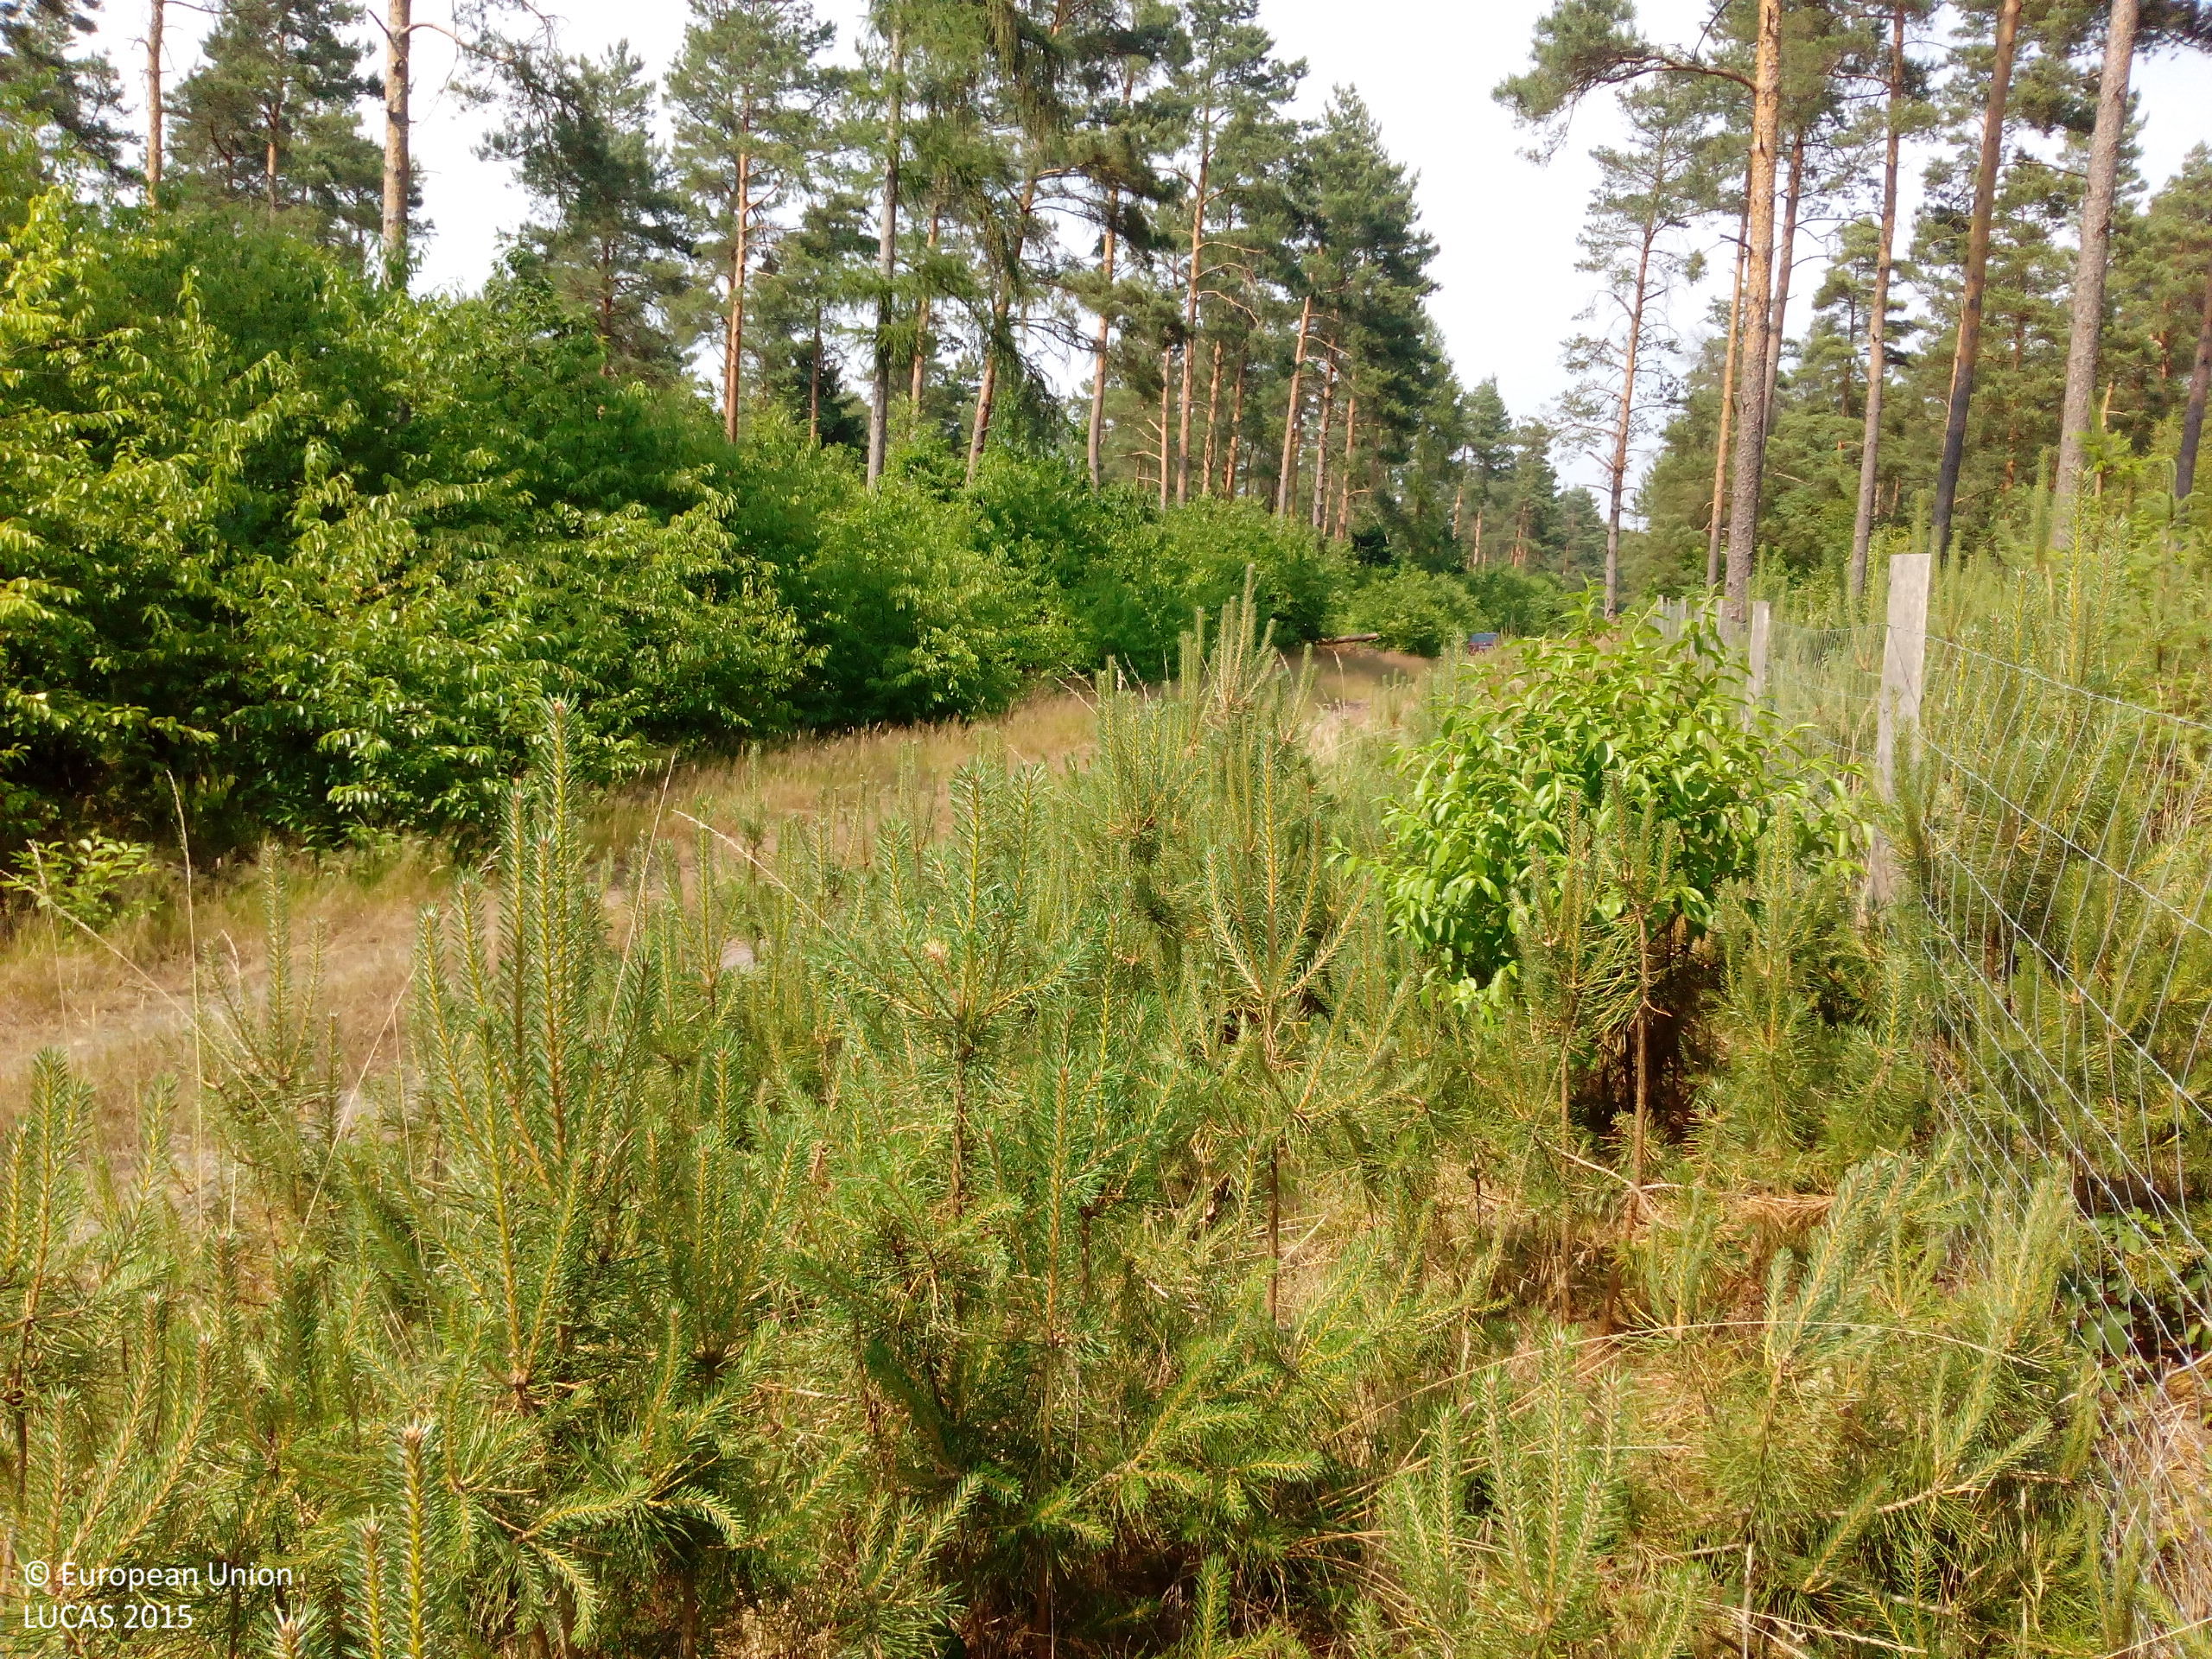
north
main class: Woodland
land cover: Other coniferous woodland
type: hemiboreal forest and nemoral coniferous forest and mixed broadleaved-coniferous forest
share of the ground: > 75 %
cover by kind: coniferous forest trees 80 %, broadleaved forest trees 10 %, herbaceous plants 10 %
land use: Forestry
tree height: > 5 m
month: July
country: DE
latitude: 52.5911
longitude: 10.6935
